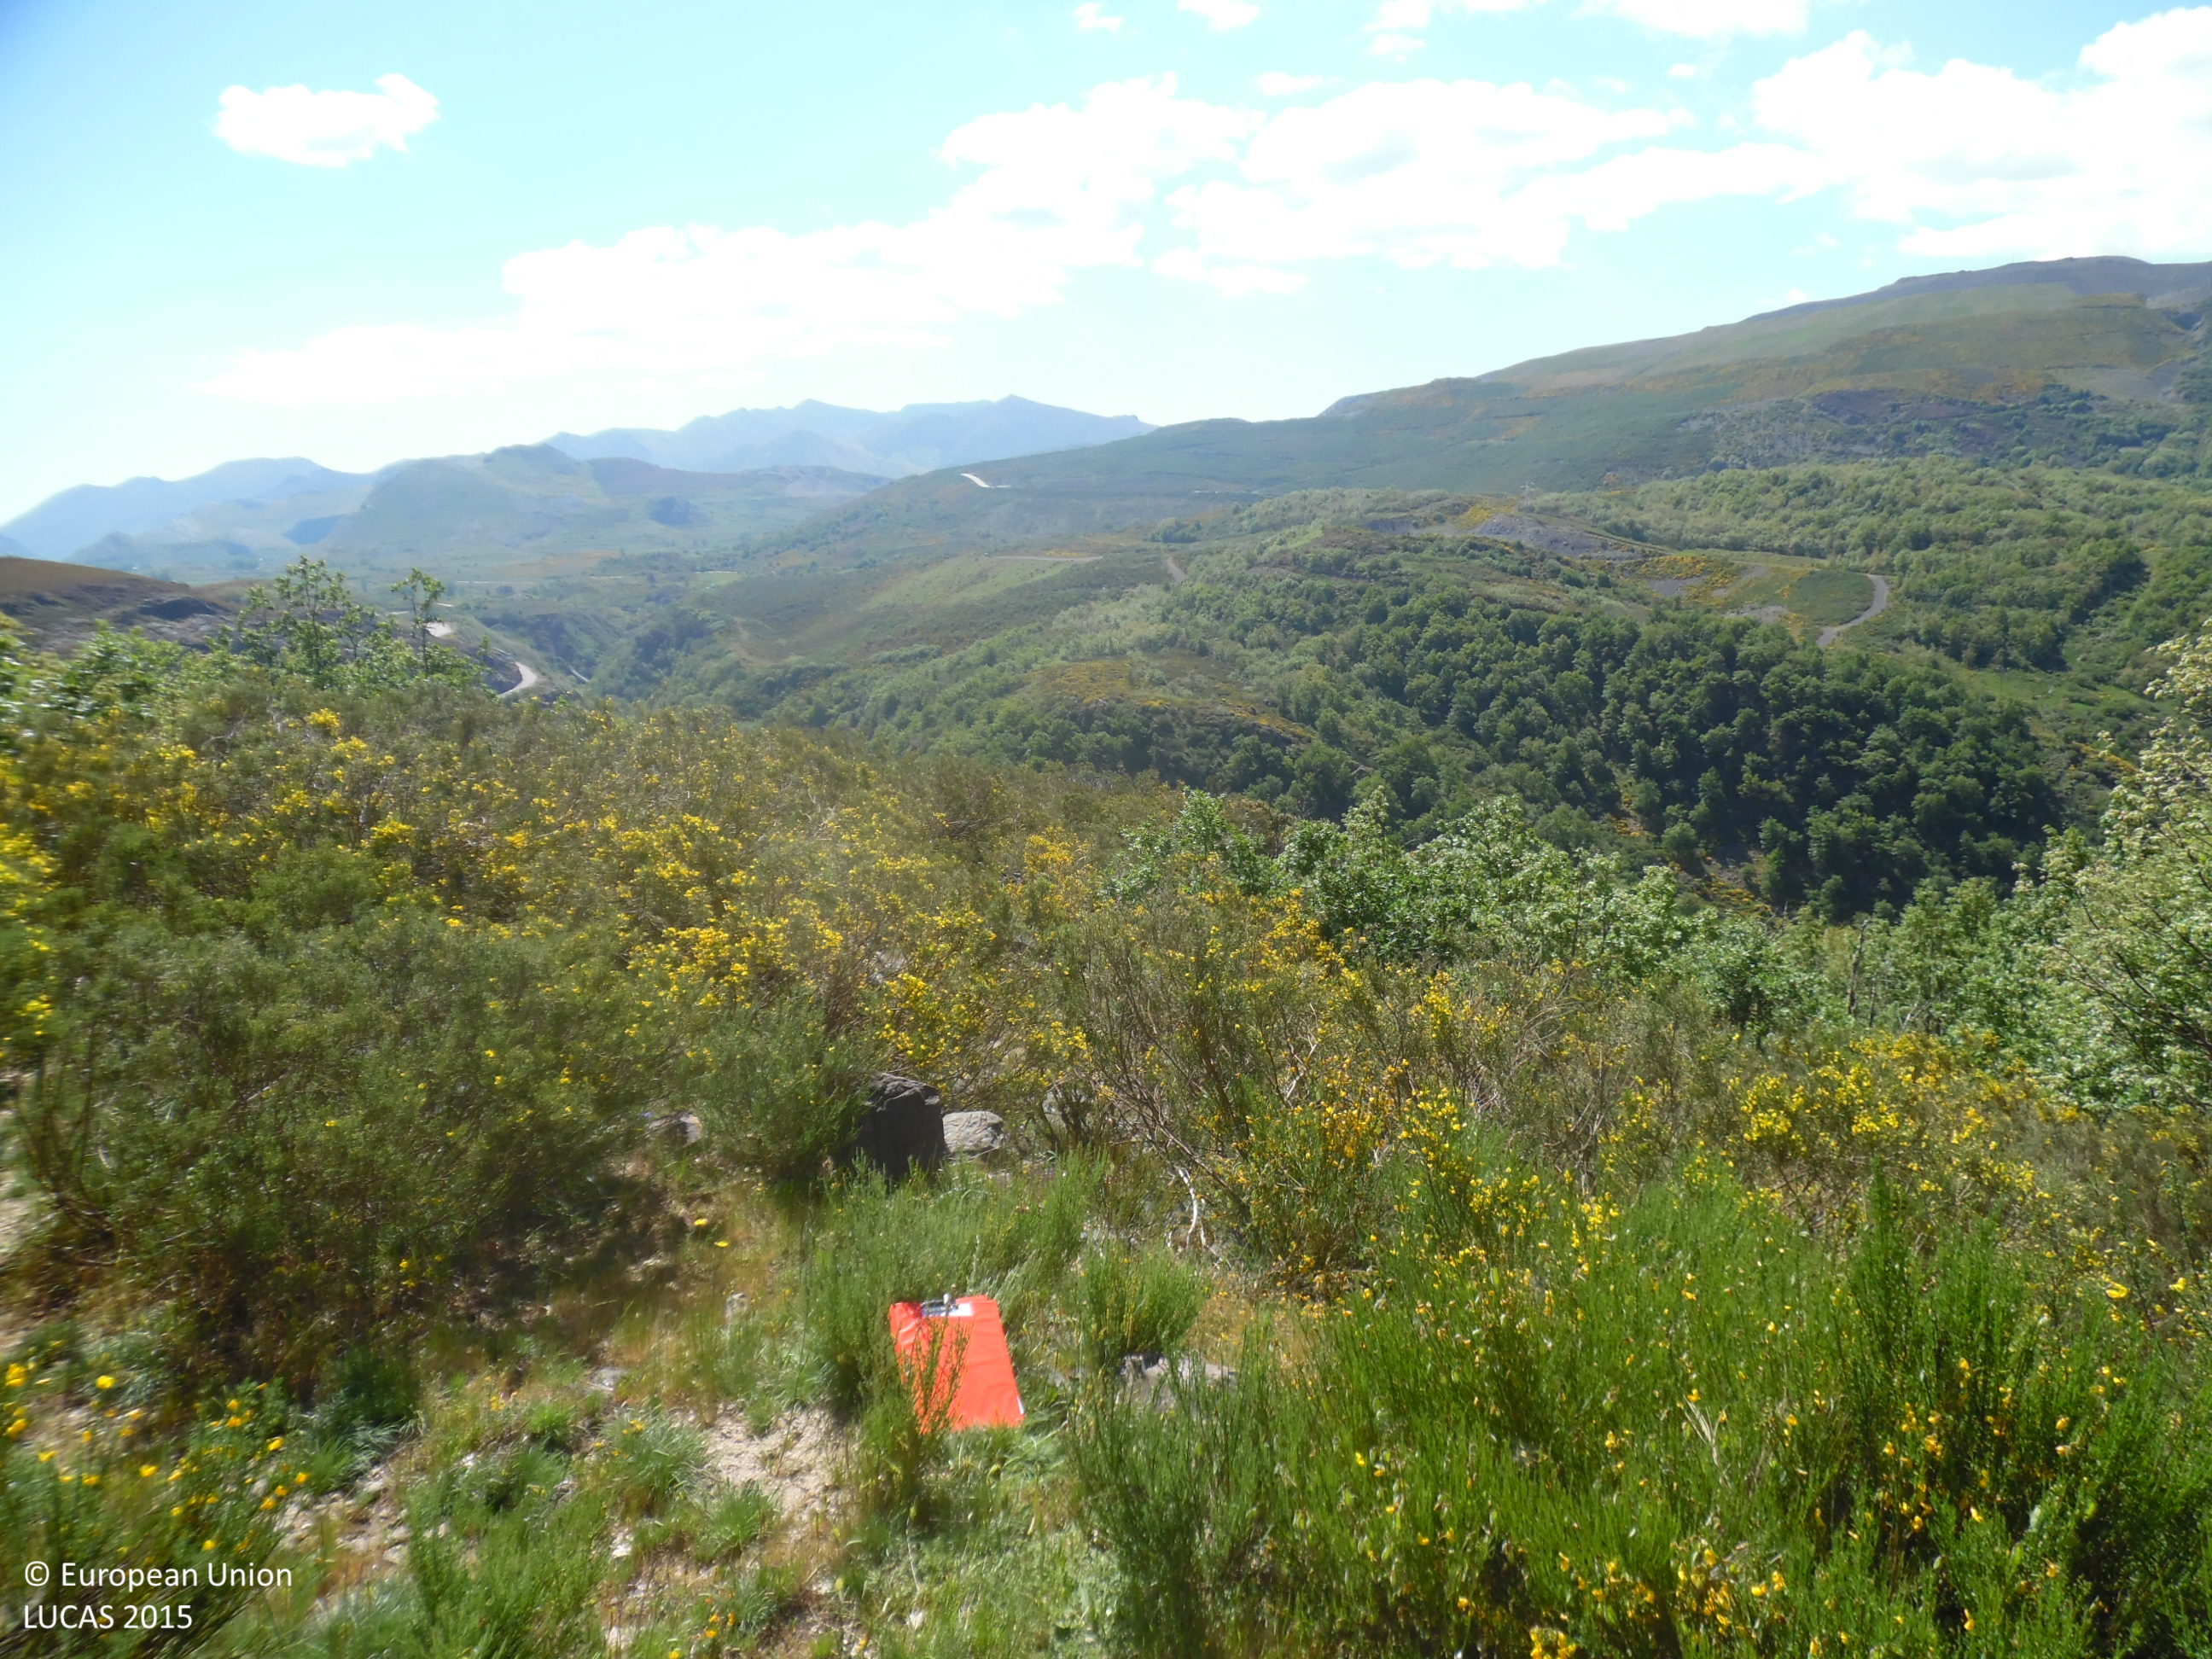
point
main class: Woodland
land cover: Broadleaved woodland
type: thermophilous deciduous forest
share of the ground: > 75 %
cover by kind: broadleaved forest trees 95 %, shrubs 5 %
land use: Forestry
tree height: > 5 m
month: May
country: ES
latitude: 42.9516
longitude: -6.2343
